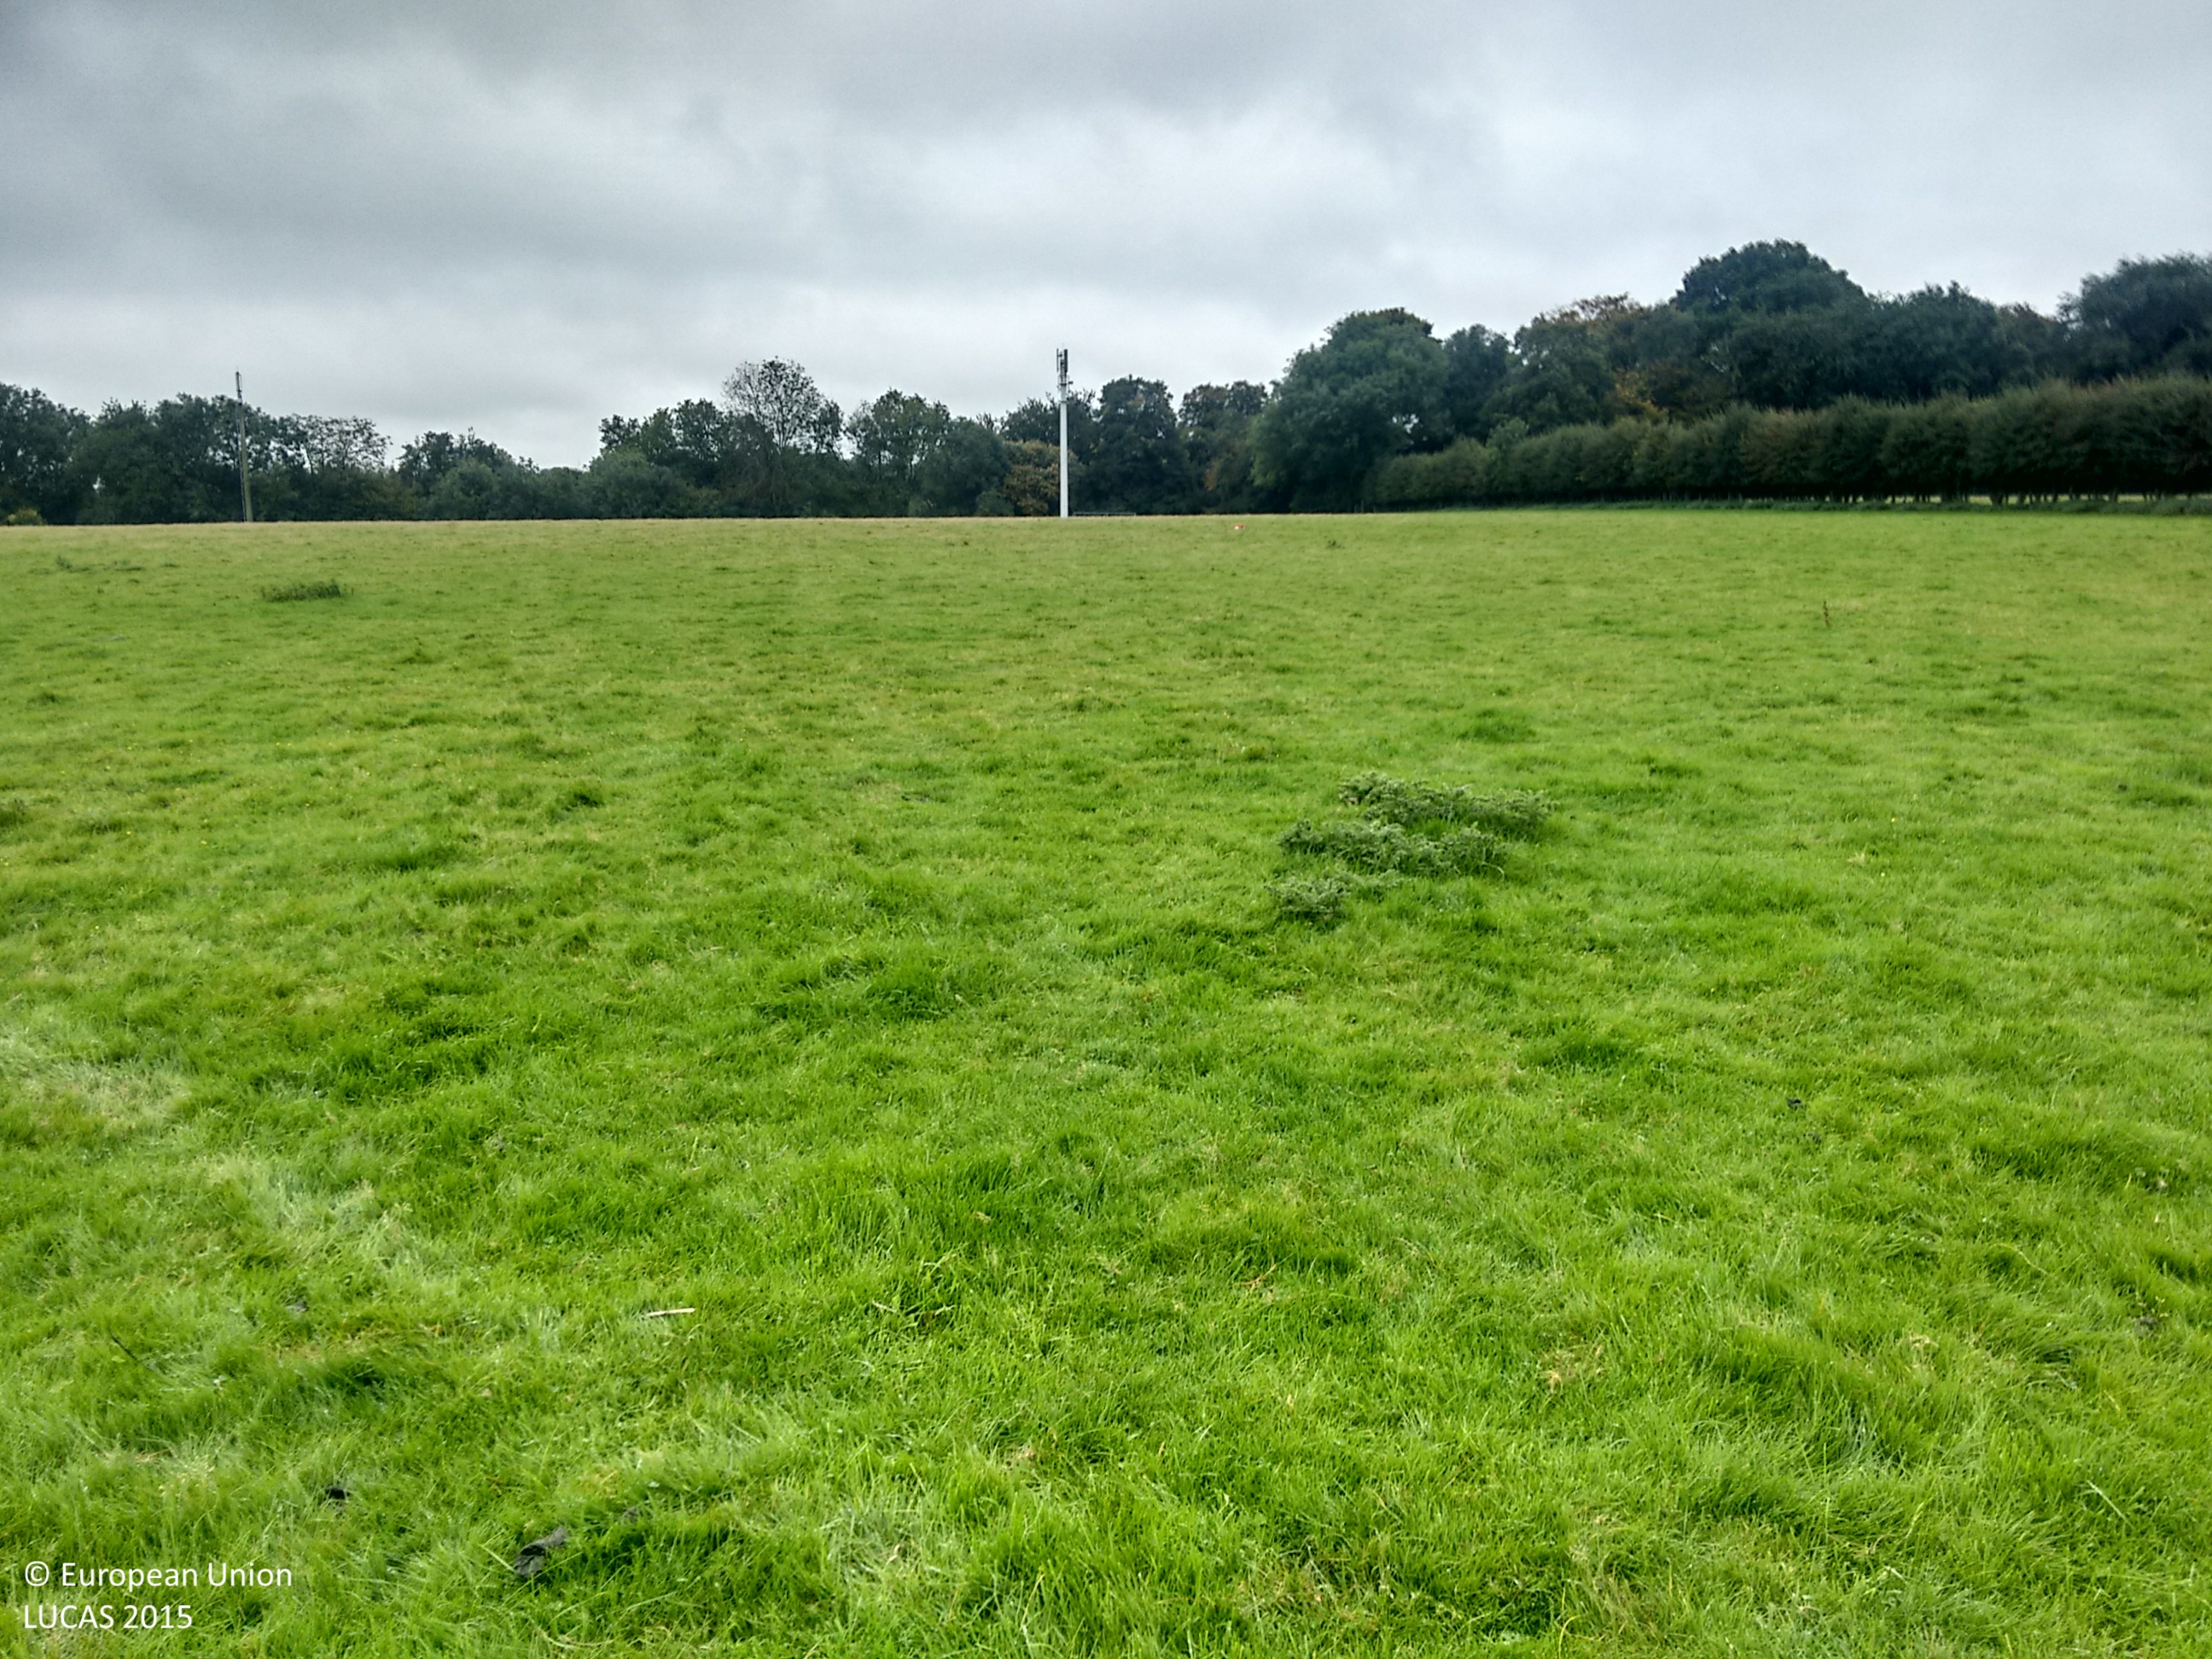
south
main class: Grassland
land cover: Grassland without tree/shrub cover
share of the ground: > 75 %
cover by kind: herbaceous plants 100 %
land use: Agriculture (excluding fallow land and kitchen gardens)
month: October
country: GB
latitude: 51.3185
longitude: 0.6325
